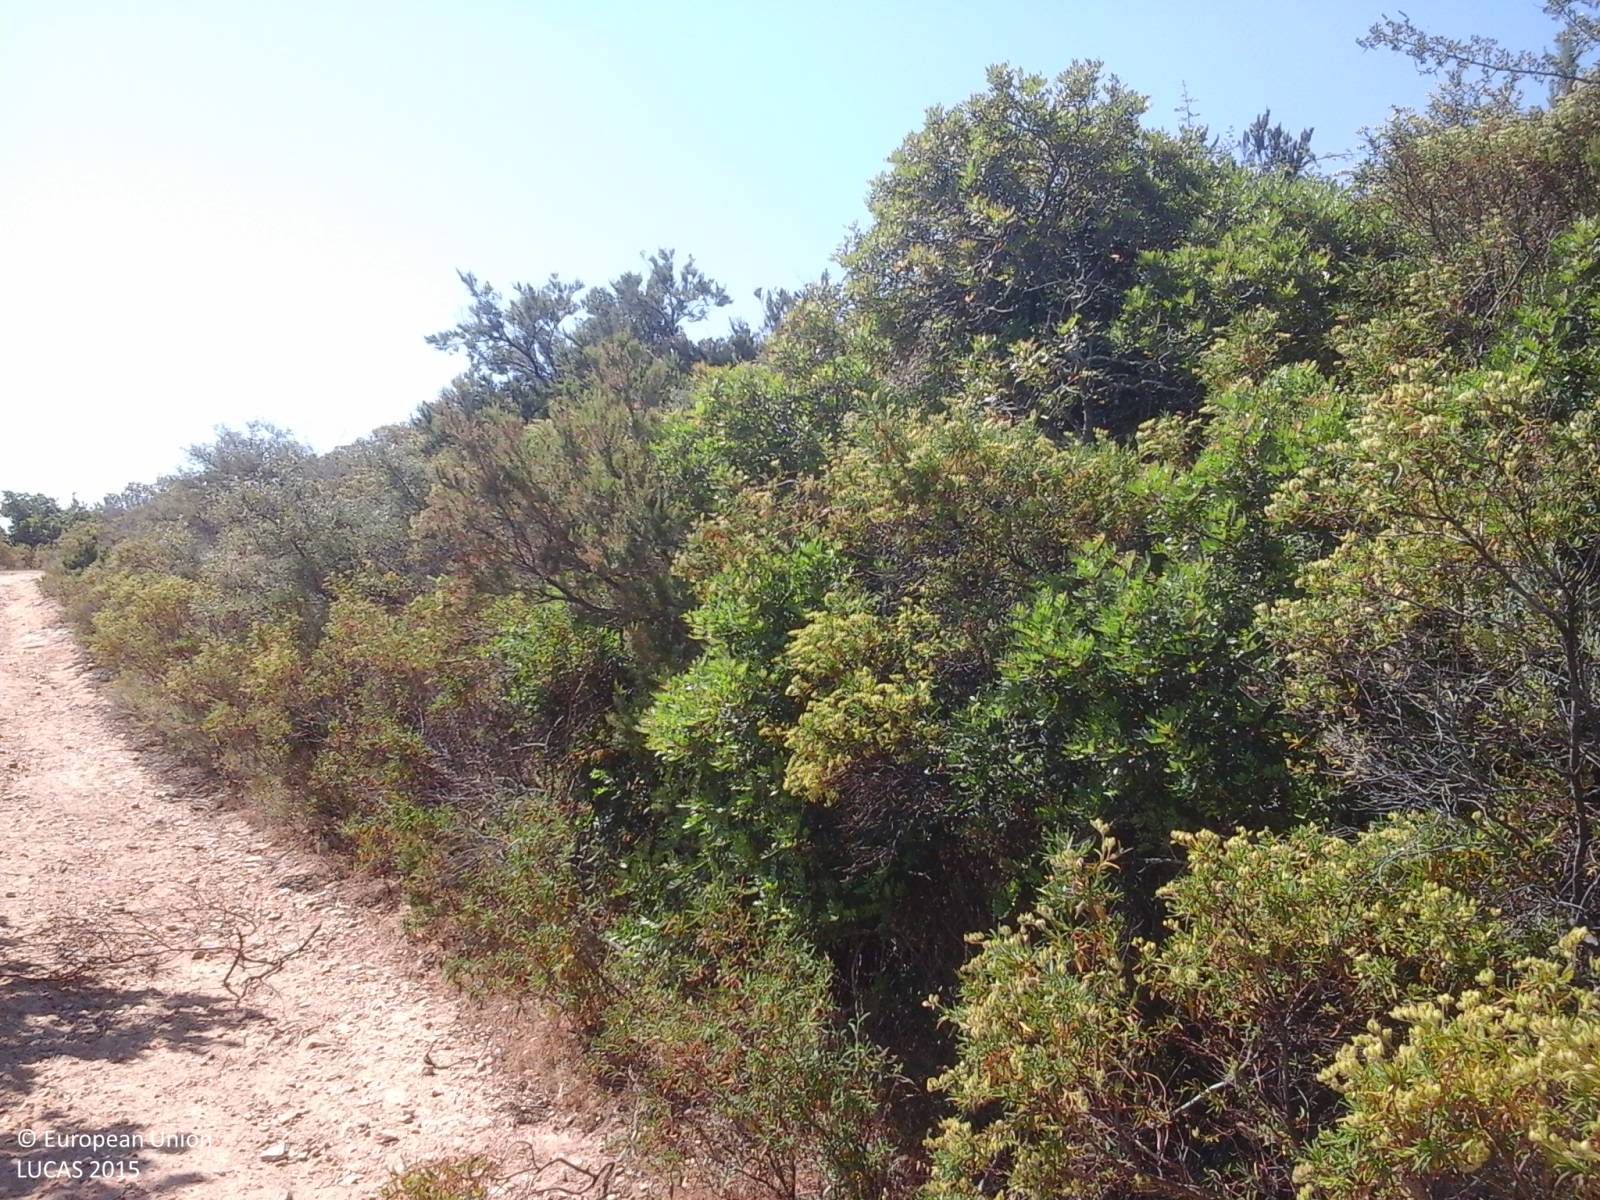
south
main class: Shrubland
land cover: Shrubland without tree cover
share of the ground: > 75 %
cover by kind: shrubs 90 %, herbaceous plants 10 %
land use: Semi-natural and natural areas not in use
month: June
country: IT
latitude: 38.9561
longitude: 8.8420
